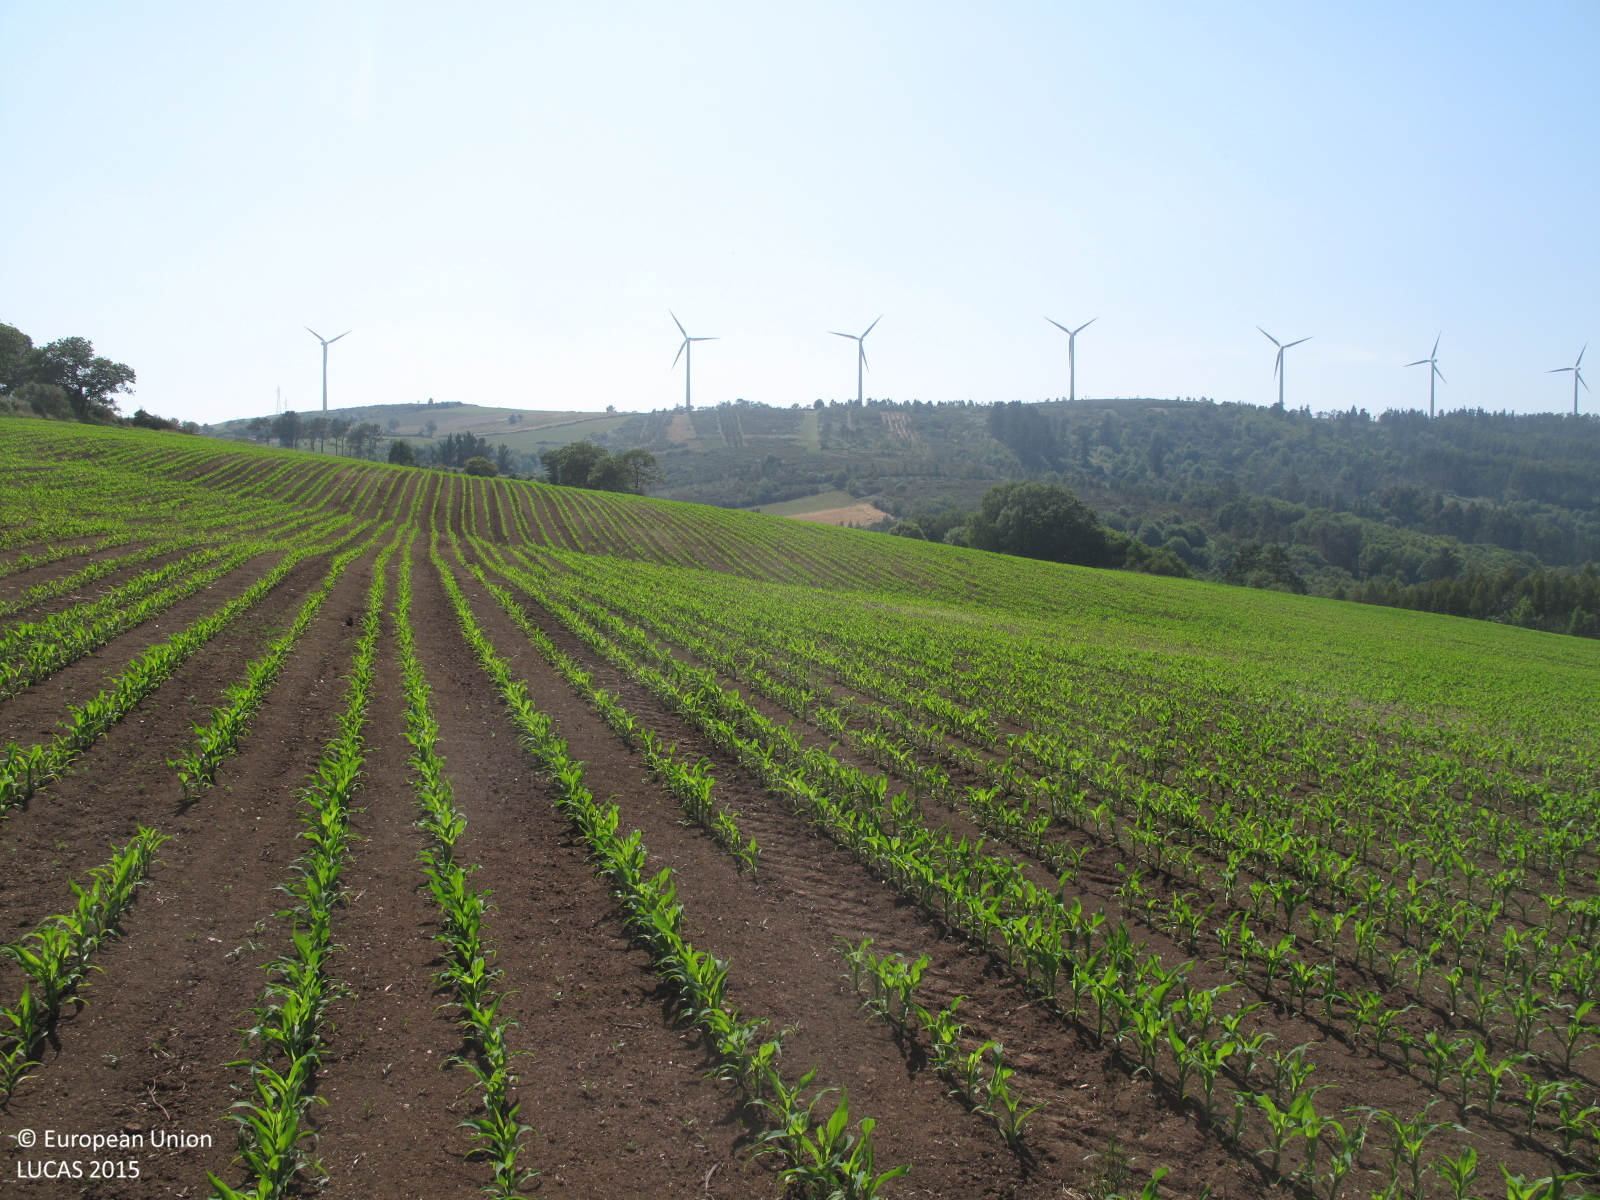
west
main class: Cropland
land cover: Maize
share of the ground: 10 - 25 %
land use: Agriculture (excluding fallow land and kitchen gardens)
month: June
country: ES
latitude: 43.2817
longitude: -7.9735
